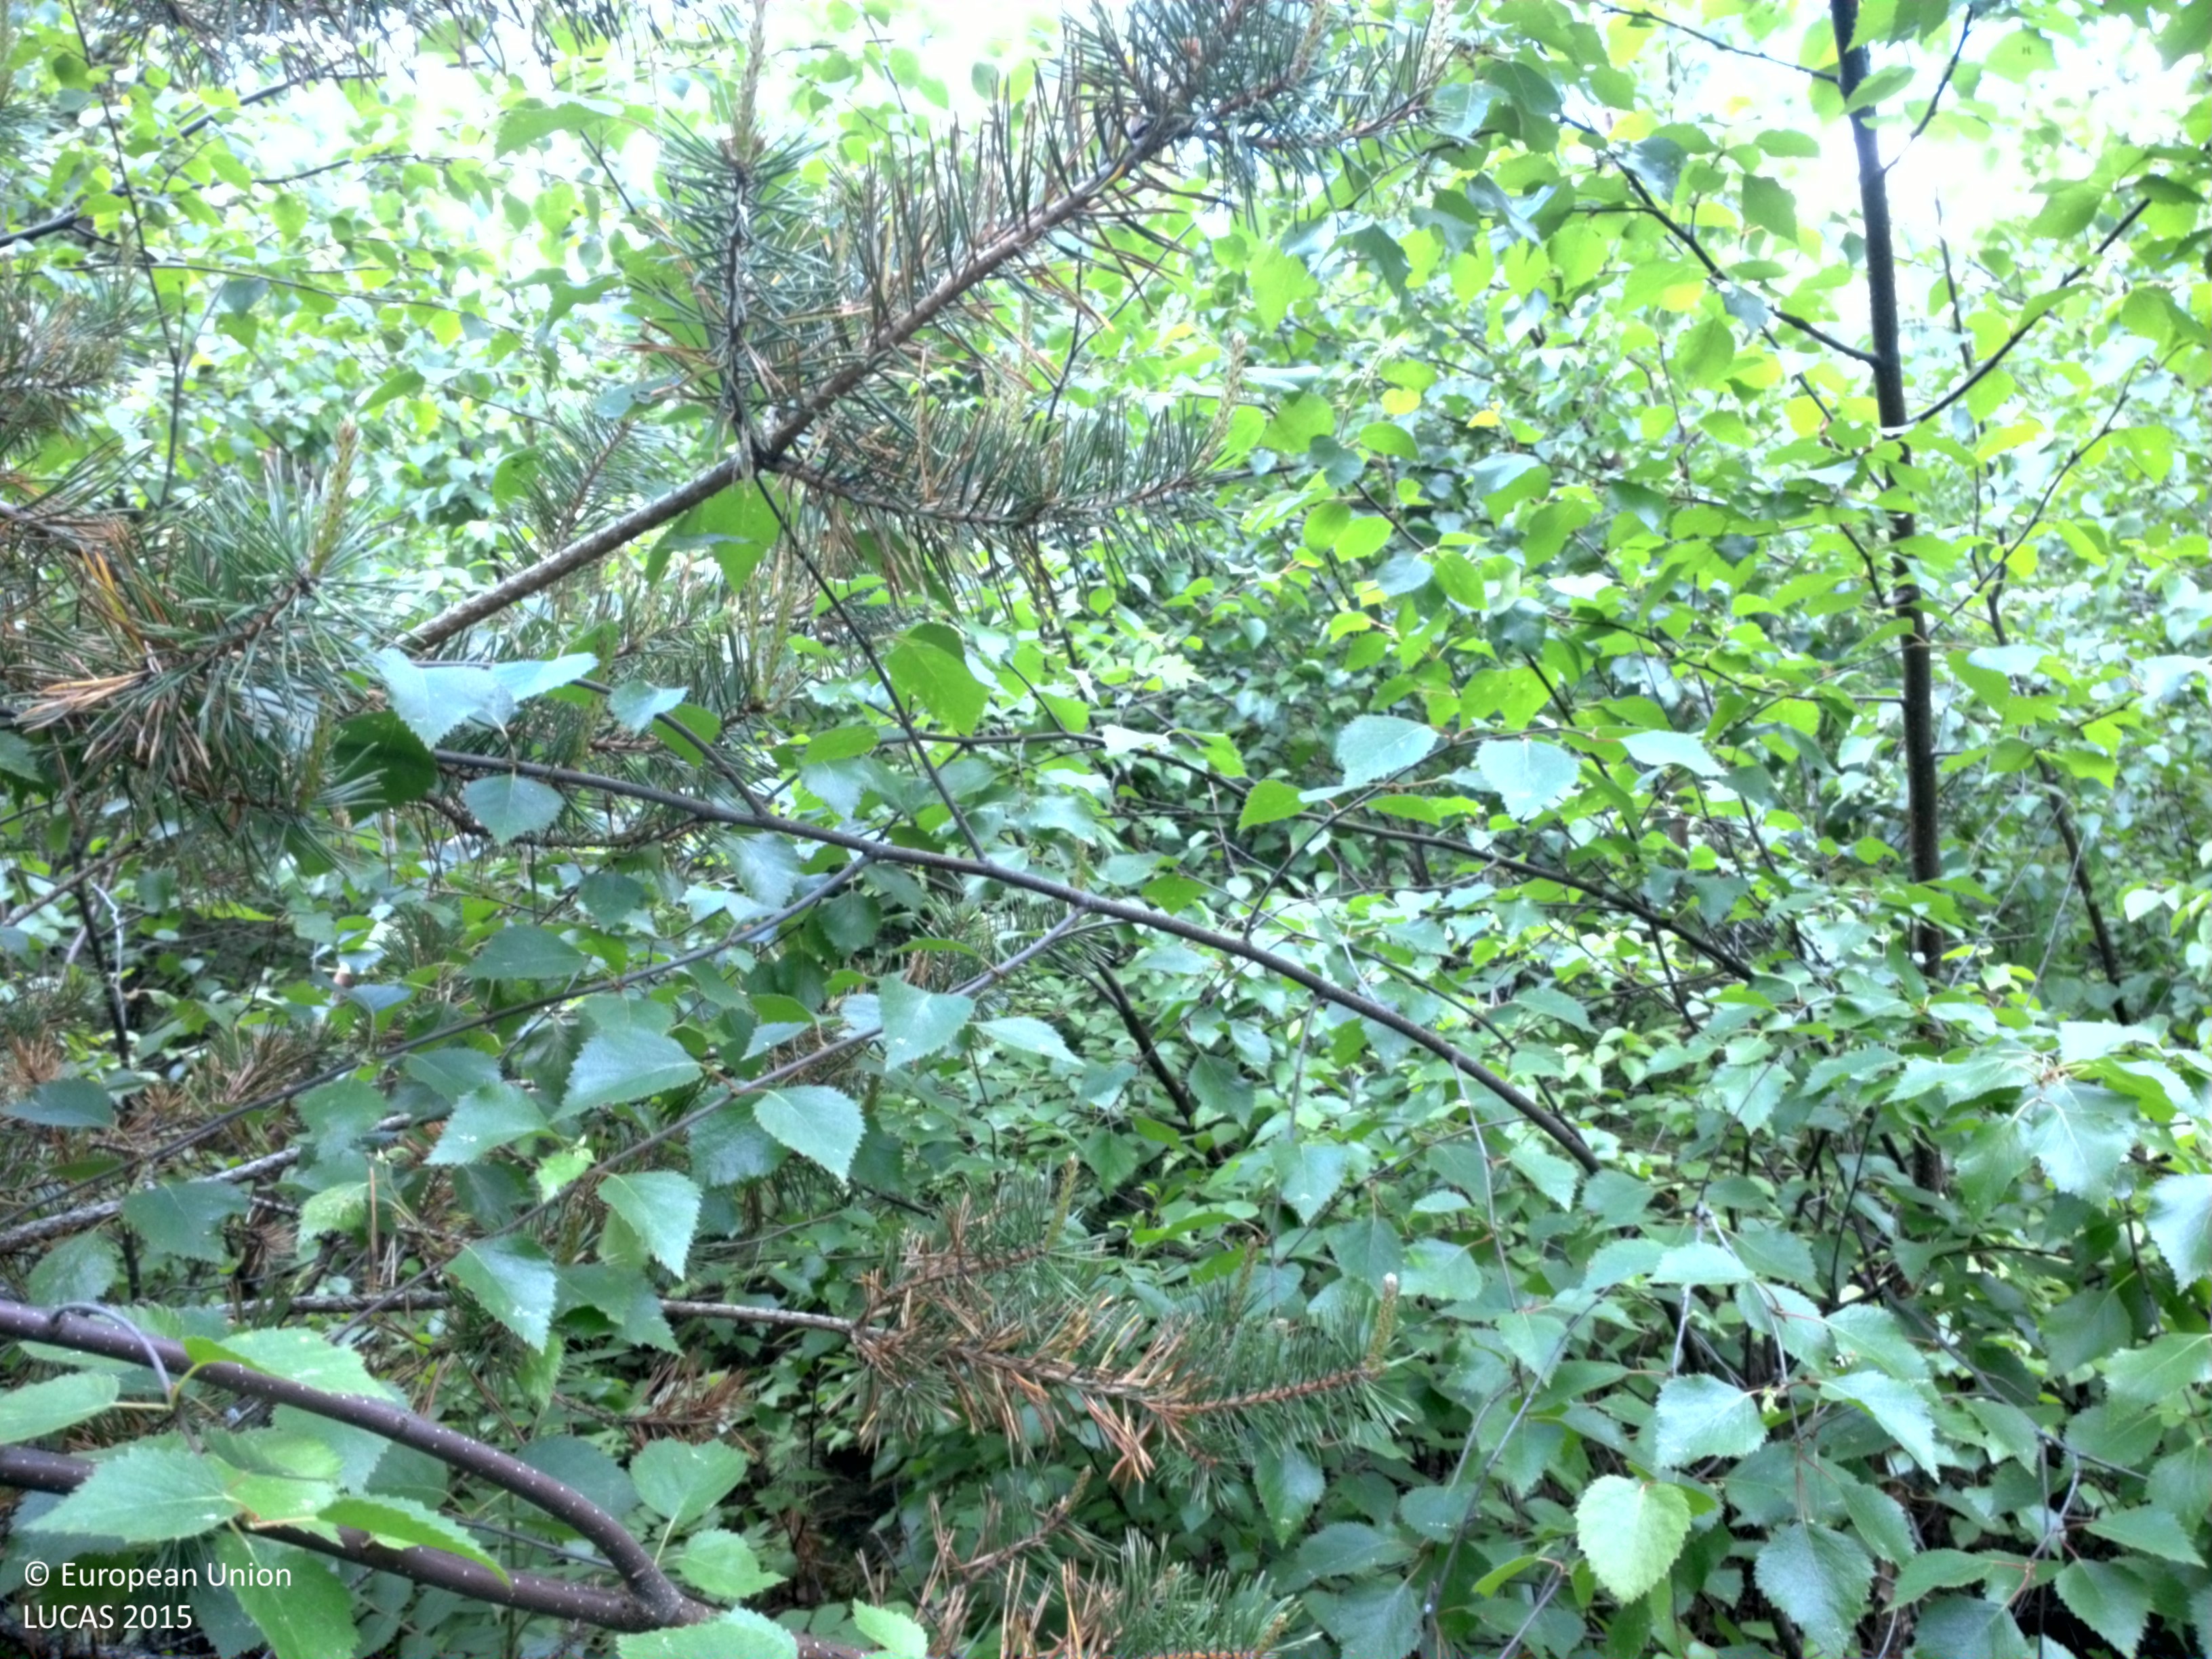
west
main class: Woodland
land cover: Pine dominated mixed woodland
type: boreal forest
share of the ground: > 75 %
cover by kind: broadleaved forest trees 60 %, coniferous forest trees 20 %, herbaceous plants 15 %, shrubs 5 %
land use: Forestry
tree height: < 5 m
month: July
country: SE
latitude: 64.3211
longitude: 20.7985
